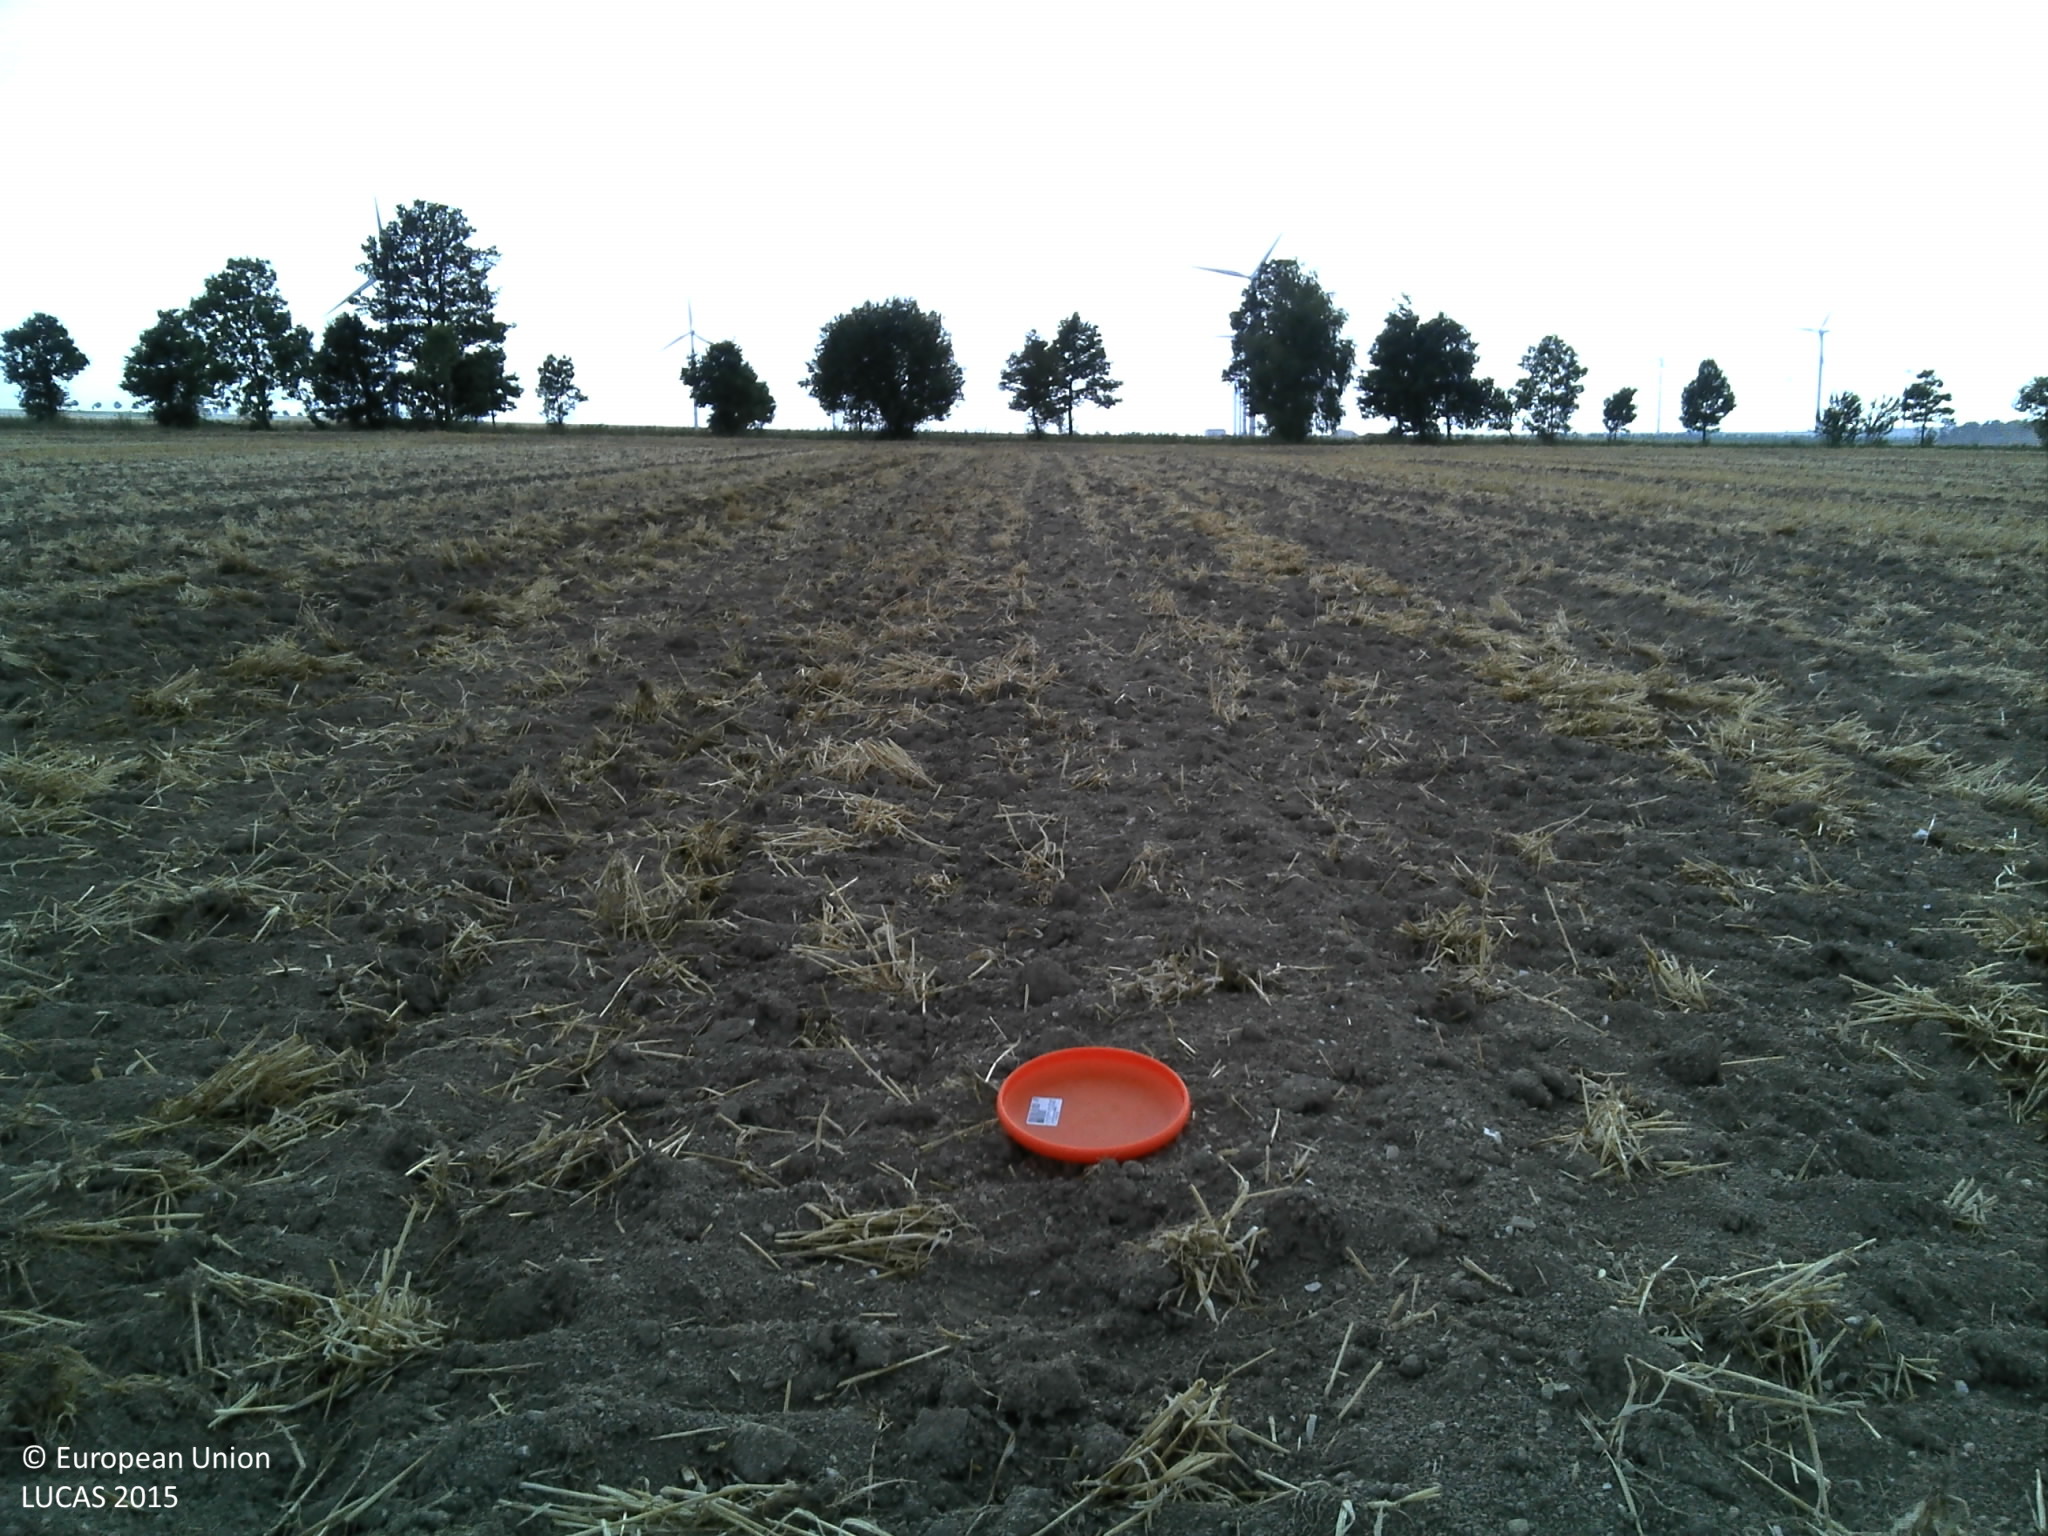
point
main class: Cropland
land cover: Barley
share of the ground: > 75 %
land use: Agriculture (excluding fallow land and kitchen gardens)
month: August
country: FR
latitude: 48.9019
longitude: 4.2254
